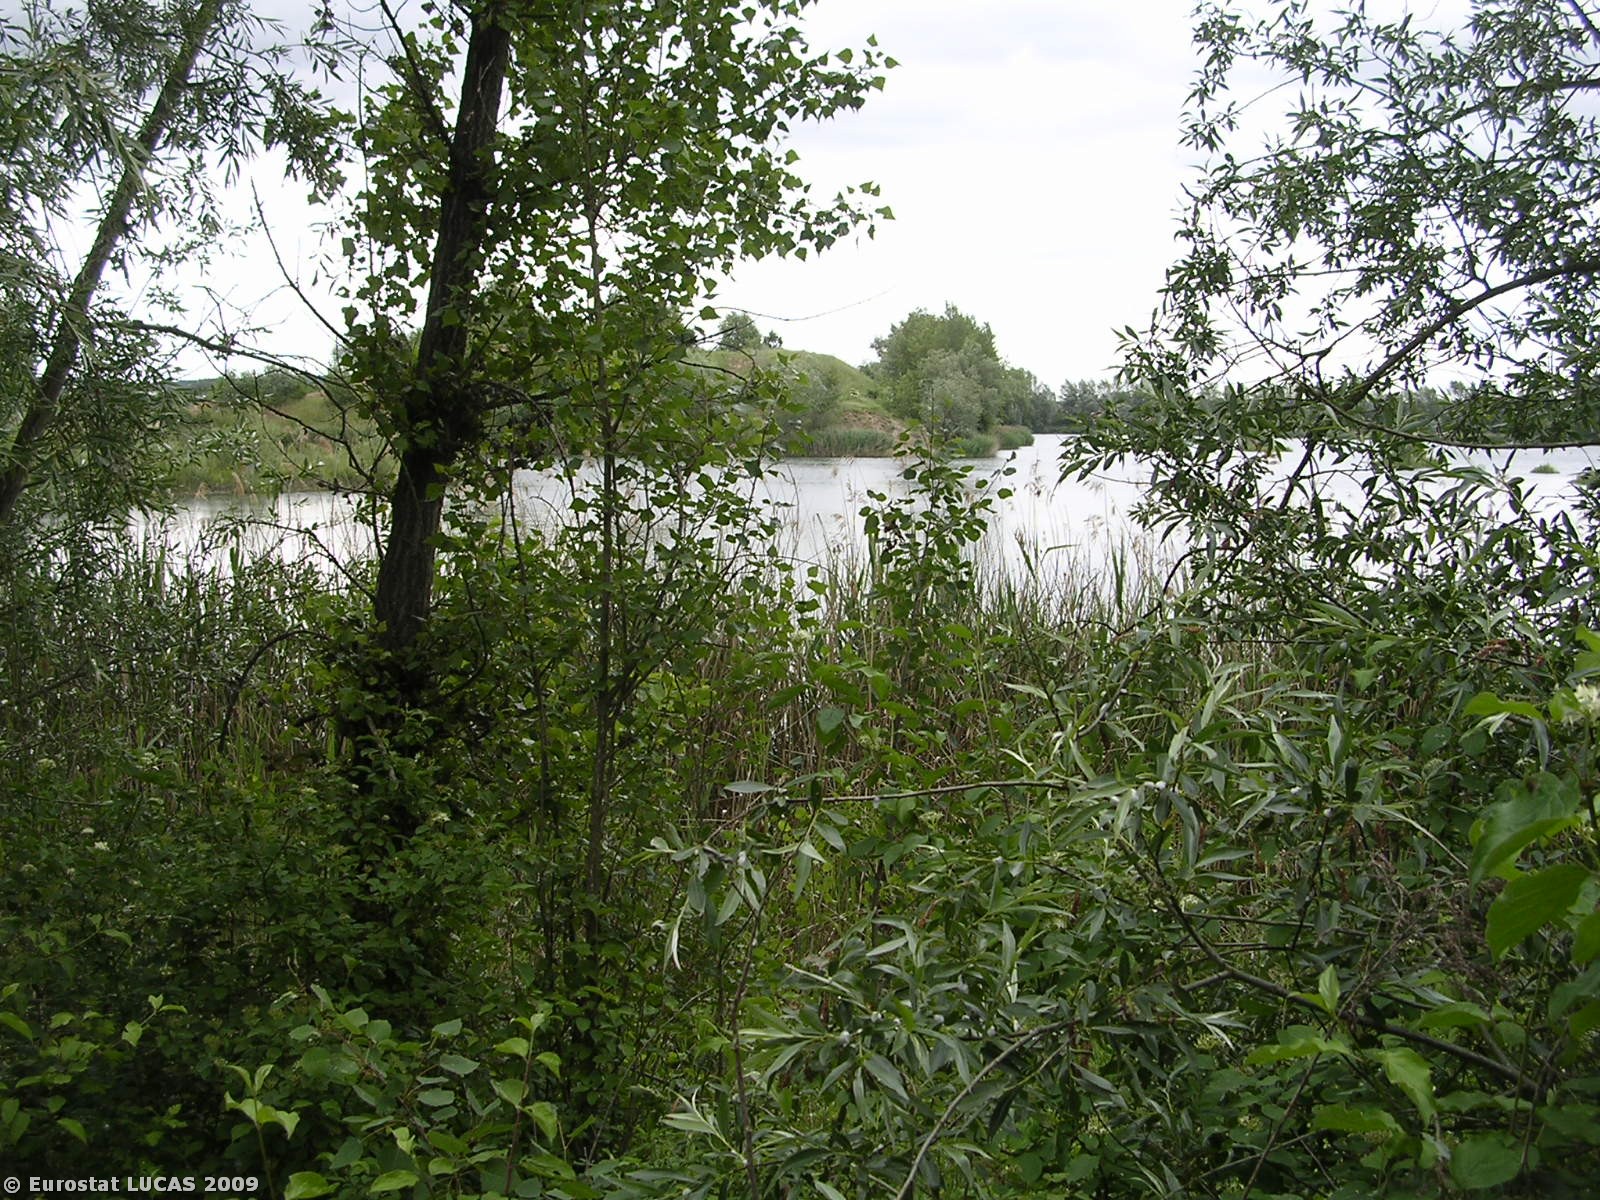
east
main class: Woodland
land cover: Broadleaved woodland
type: floodplain forest
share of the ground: 50 - 75 %
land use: Forestry
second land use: Amenities, museums, leisure
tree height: > 5 m
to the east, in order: Broadleaved woodland; Inland marshes; Inland water bodies; Inland marshes; Grassland with sparse tree/shrub cover
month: May
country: CZ
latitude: 50.3683
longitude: 14.4303
